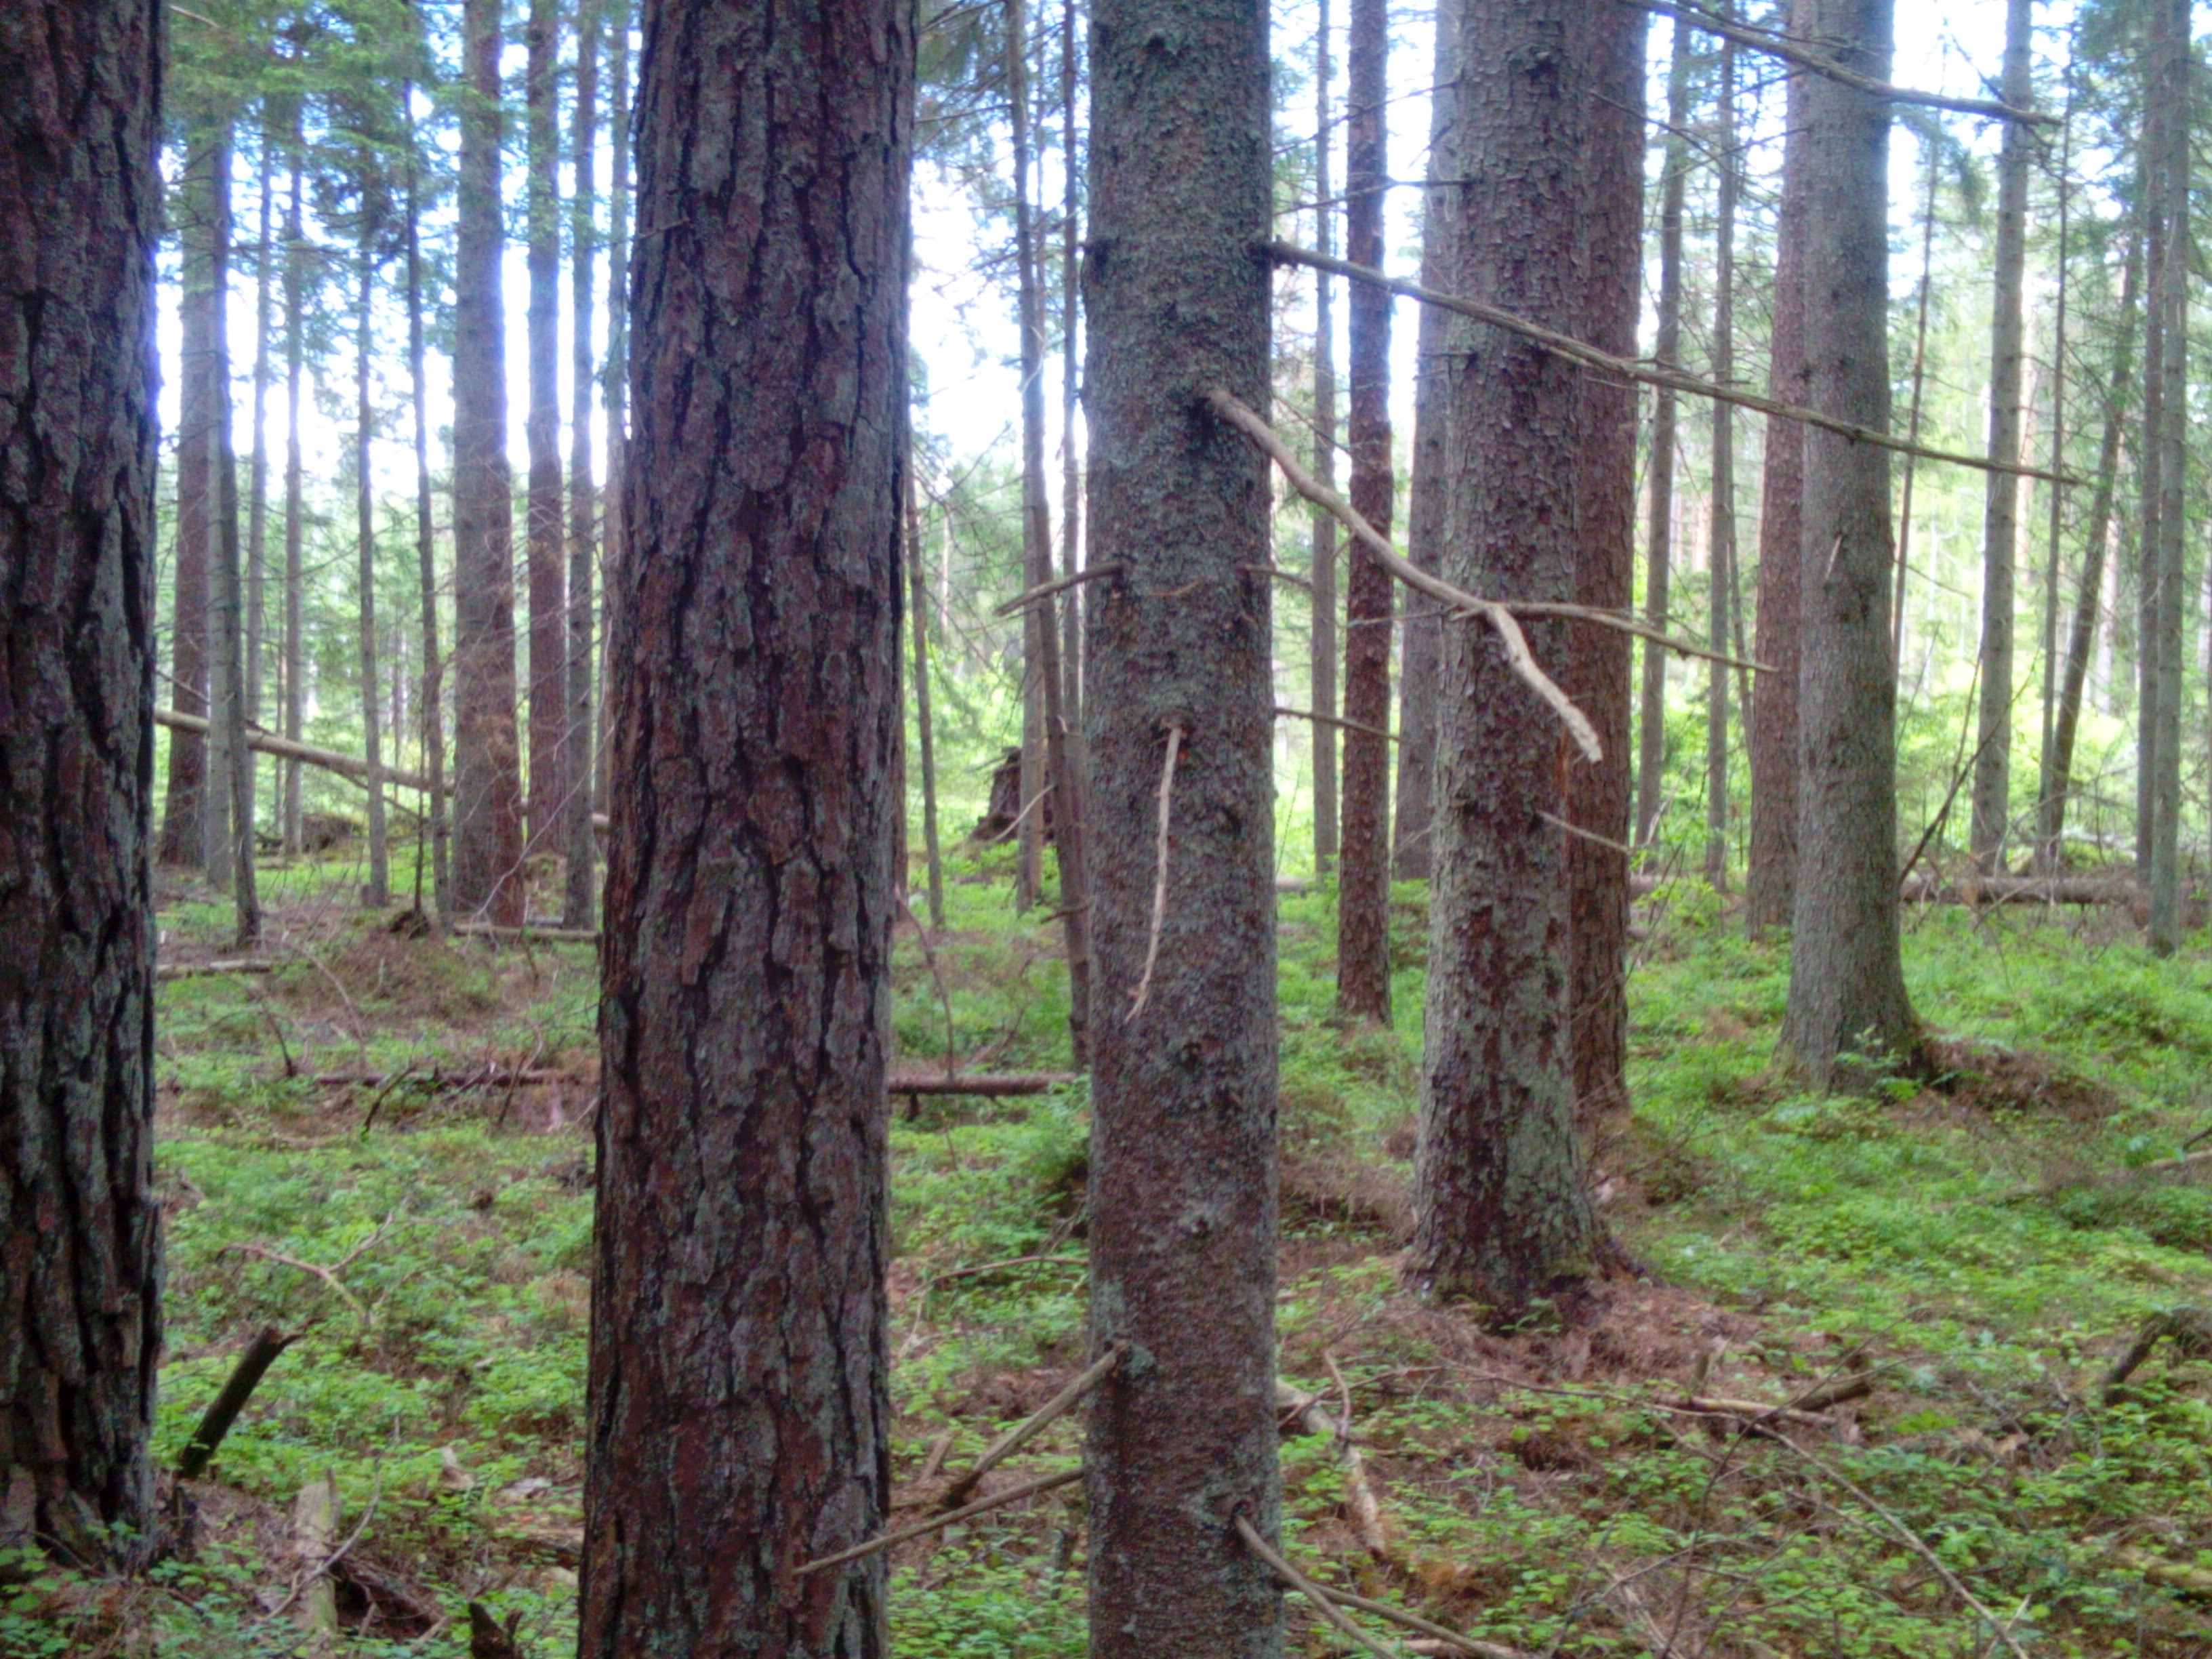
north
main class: Woodland
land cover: Other coniferous woodland
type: hemiboreal forest and nemoral coniferous forest and mixed broadleaved-coniferous forest
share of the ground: > 75 %
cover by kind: coniferous forest trees 85 %, herbaceous plants 10 %, lichens and mosses 5 %
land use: Forestry
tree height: > 5 m
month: June
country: LV
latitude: 56.8180
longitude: 21.4592
